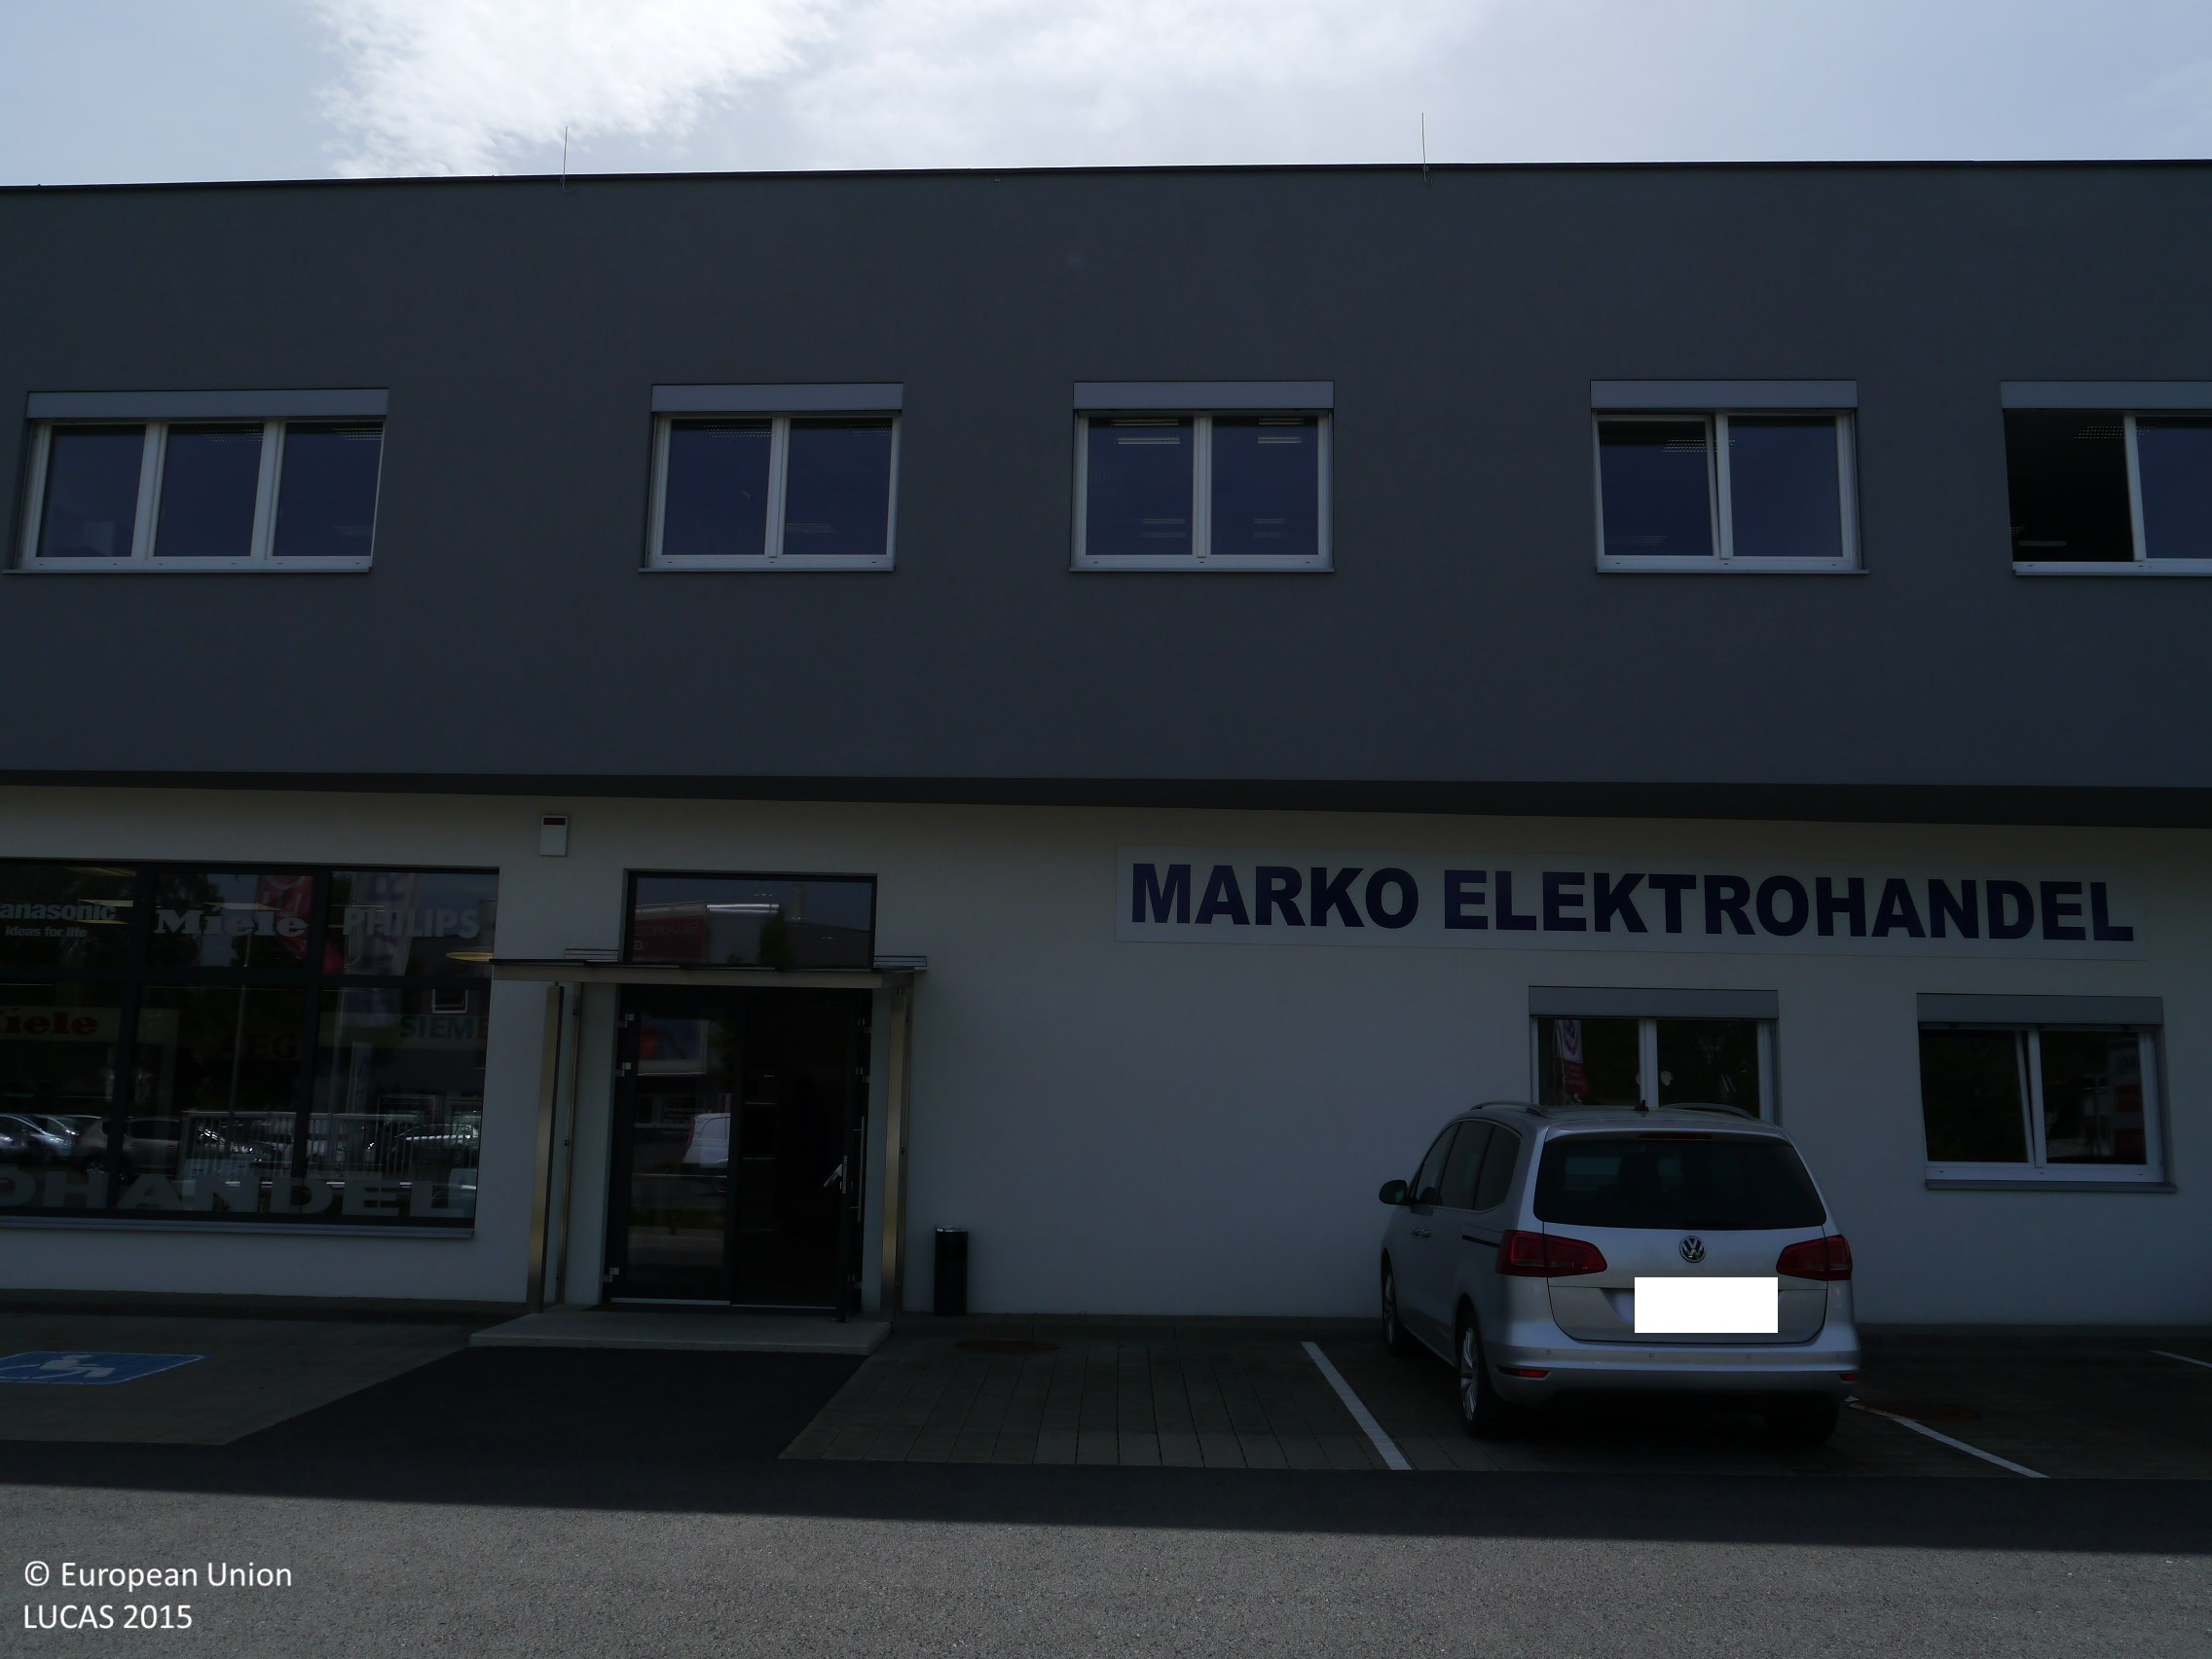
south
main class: Grassland
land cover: Grassland with sparse tree/shrub cover
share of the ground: > 75 %
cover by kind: herbaceous plants 95 %, broadleaved forest trees 5 %
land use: Commerce
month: May
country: AT
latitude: 47.0432
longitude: 15.4356
